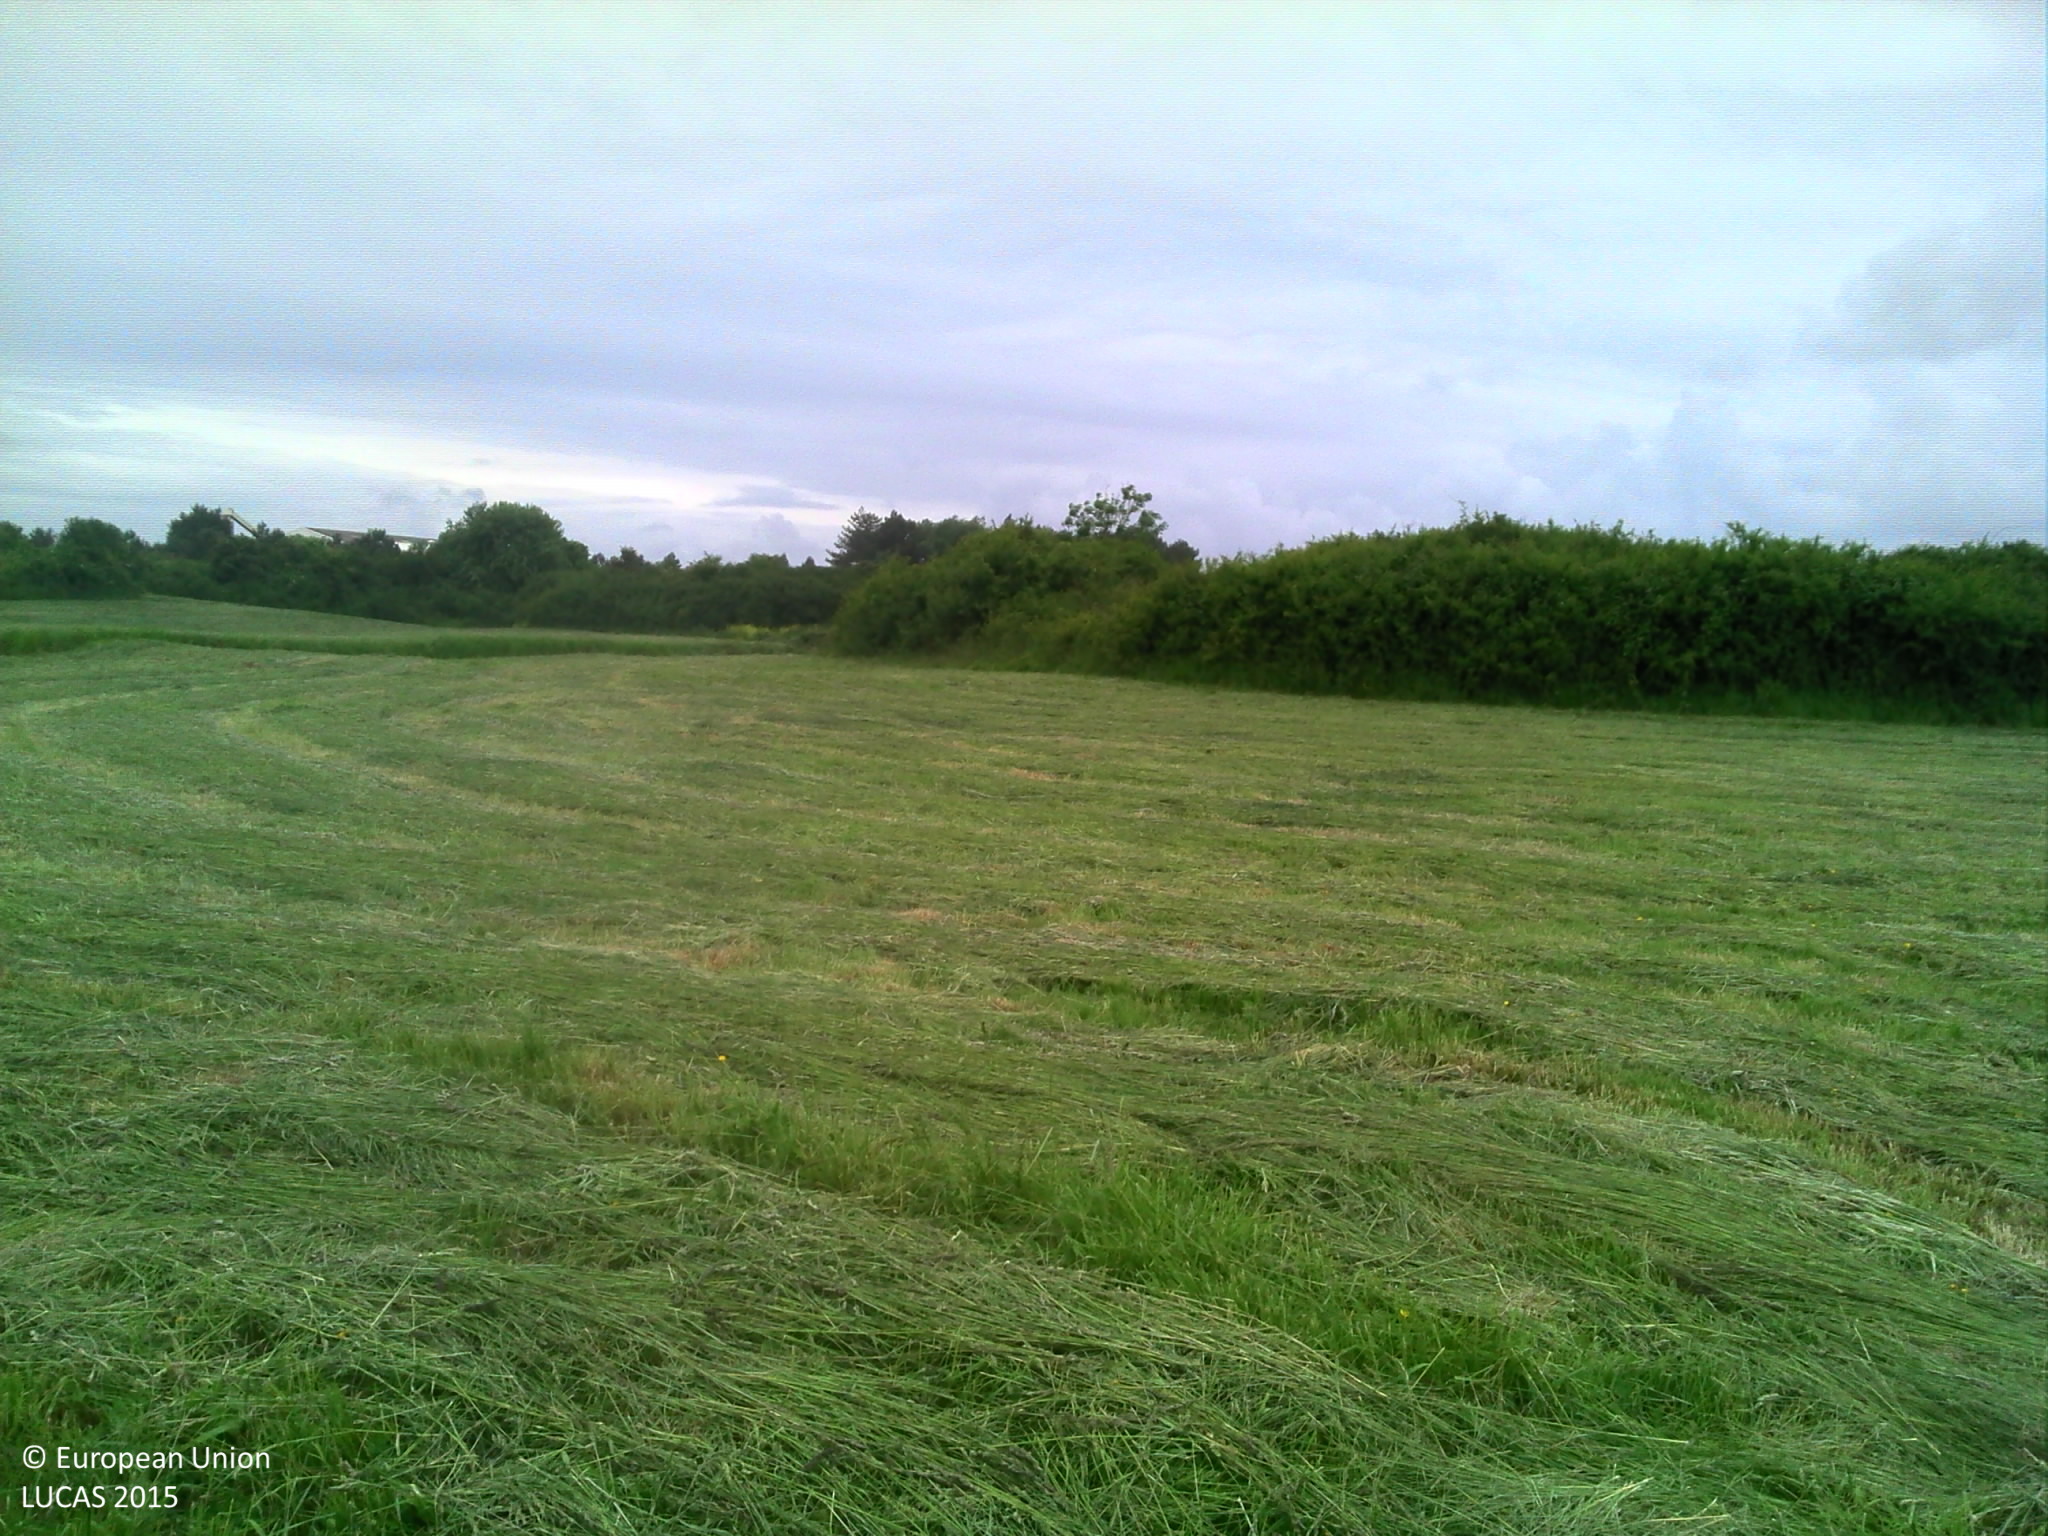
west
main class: Grassland
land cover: Grassland without tree/shrub cover
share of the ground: > 75 %
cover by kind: herbaceous plants 100 %
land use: Agriculture (excluding fallow land and kitchen gardens)
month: May
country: FR
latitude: 50.2144
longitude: 1.5591
